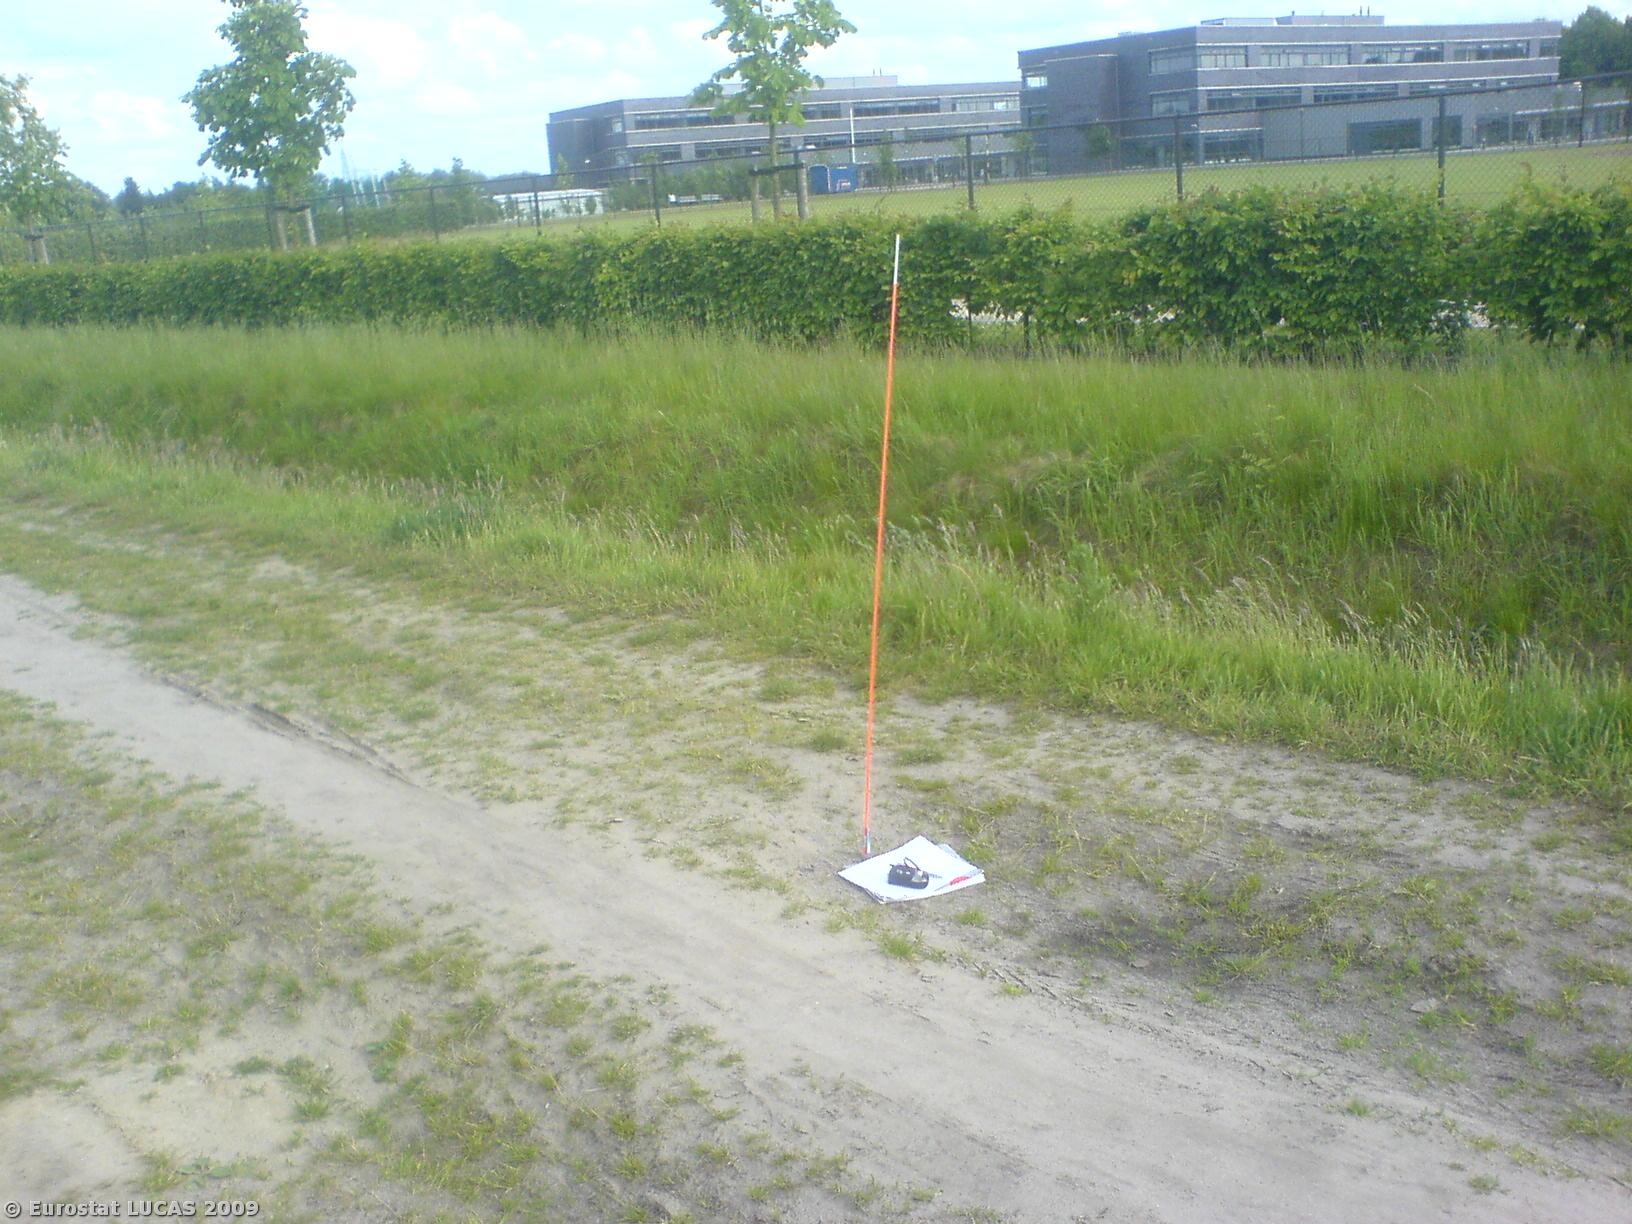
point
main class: Artificial land
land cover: Non built-up linear features
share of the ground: 10 - 25 %
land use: Road transport
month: May
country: NL
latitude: 51.4055
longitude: 5.3833
